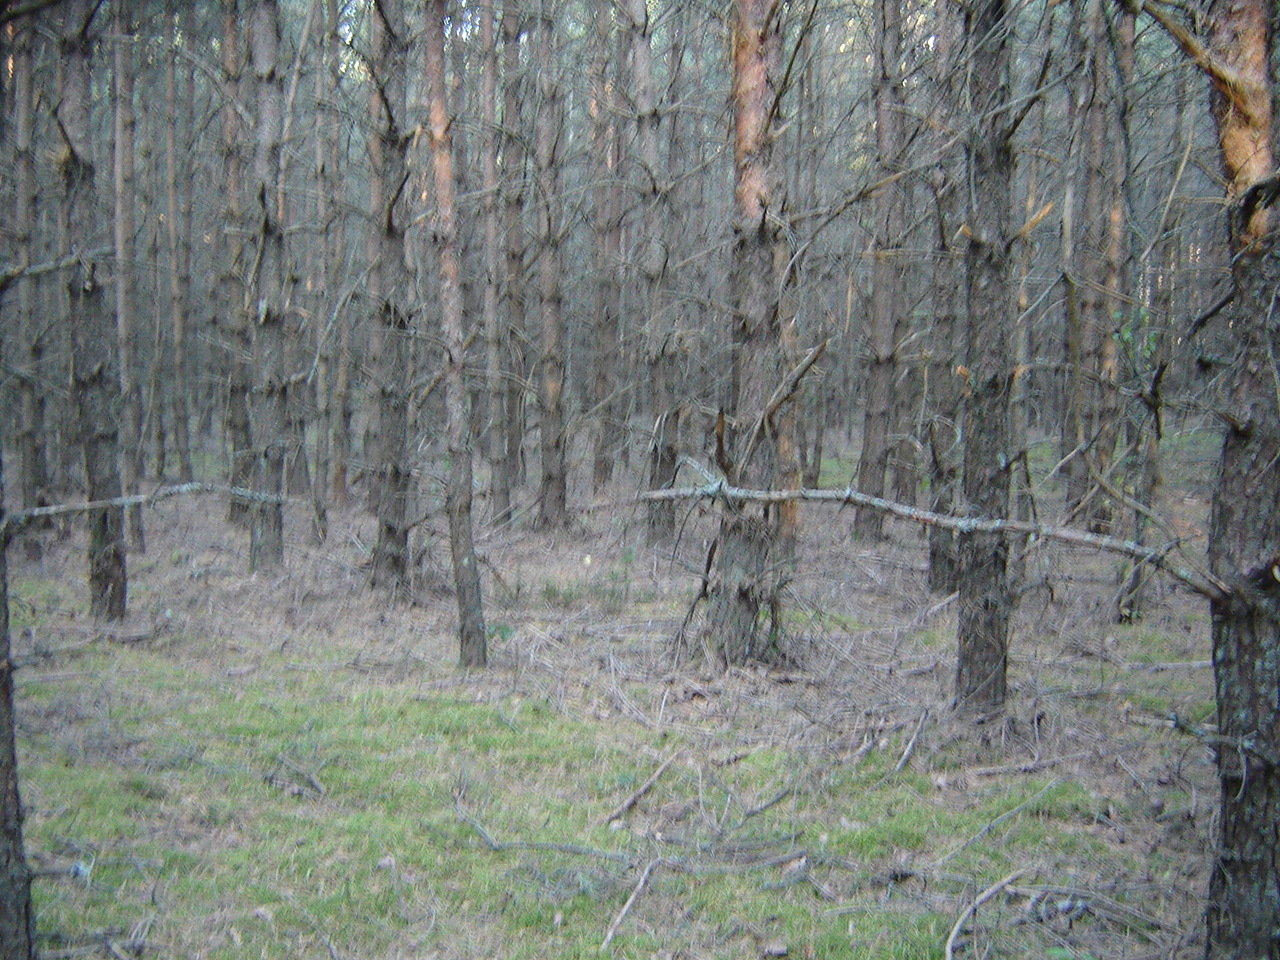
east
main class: Woodland
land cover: Pine dominated coniferous woodland
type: hemiboreal forest and nemoral coniferous forest and mixed broadleaved-coniferous forest
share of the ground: > 75 %
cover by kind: coniferous forest trees 90 %, lichens and mosses 10 %
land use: Forestry
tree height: > 5 m
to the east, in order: Pine dominated coniferous woodland; Spontaneously vegetated surfaces; Pine dominated coniferous woodland
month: August
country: LT
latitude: 54.5658
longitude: 24.8504
